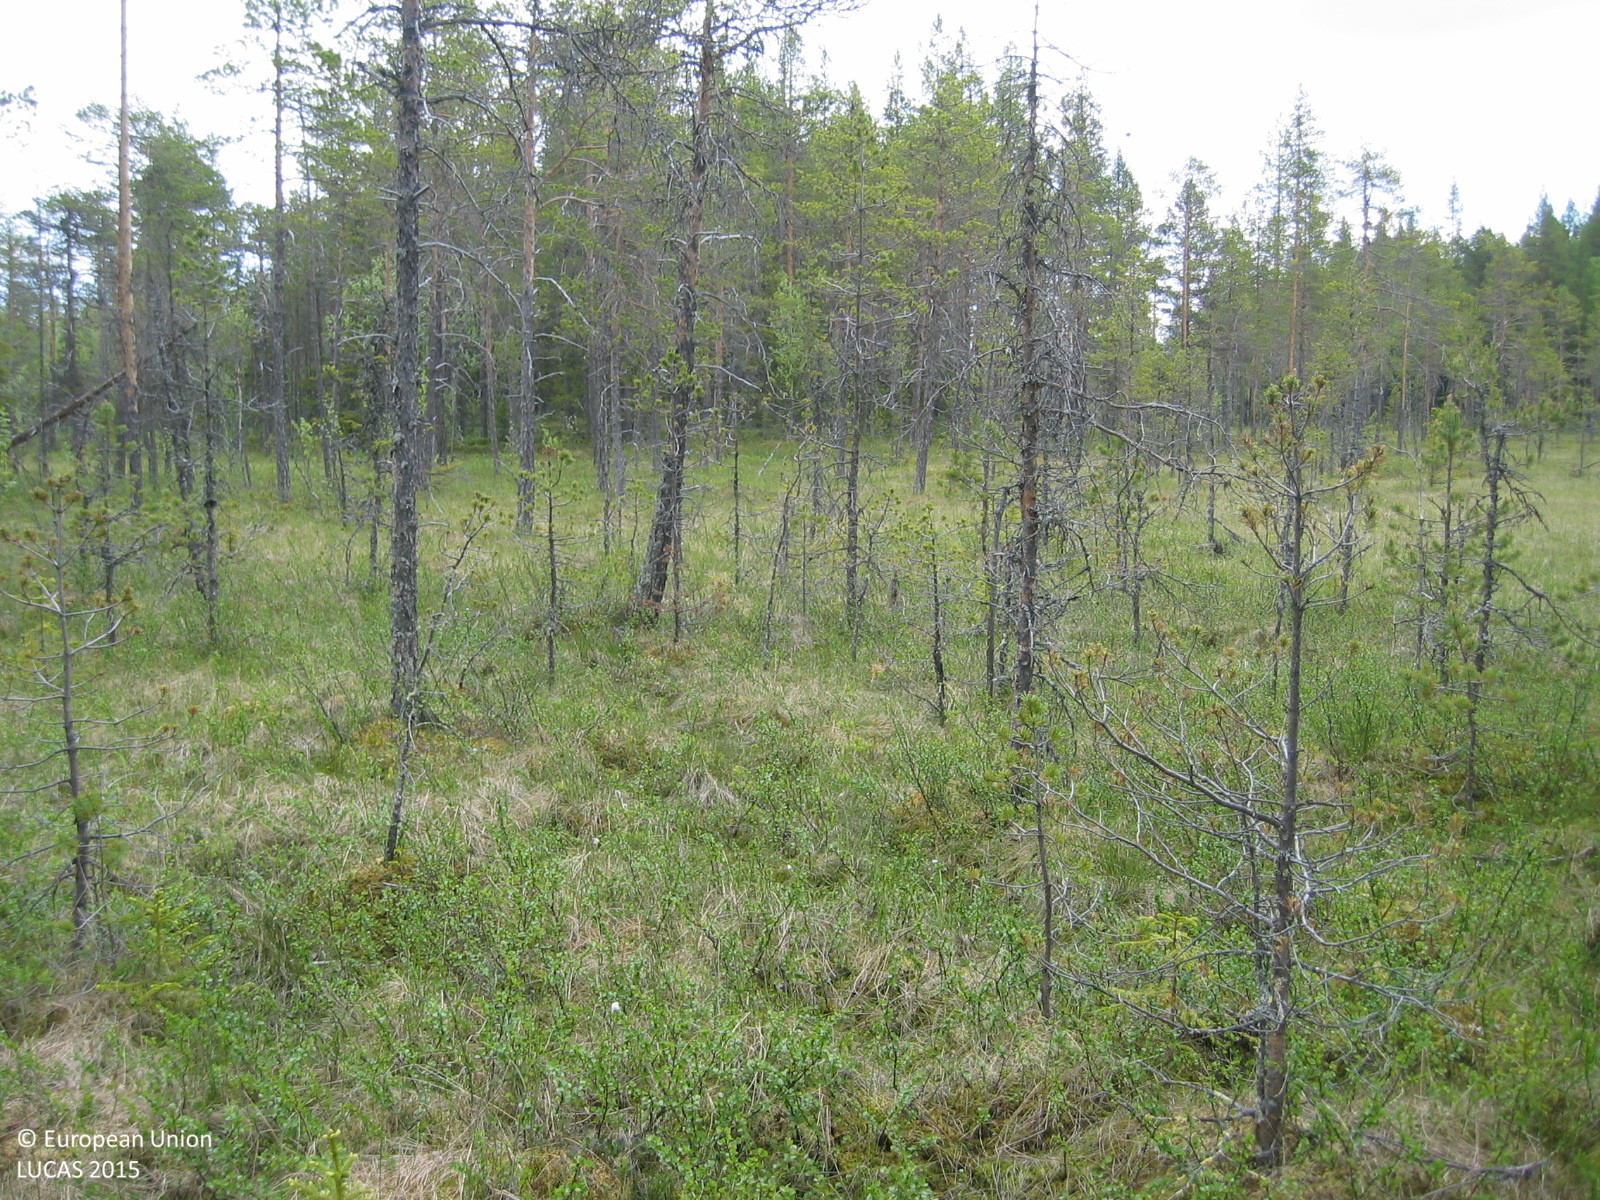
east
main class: Woodland
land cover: Pine dominated coniferous woodland
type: boreal forest
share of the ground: 50 - 75 %
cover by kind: coniferous forest trees 60 %, shrubs 40 %
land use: Semi-natural and natural areas not in use
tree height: > 5 m
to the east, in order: Pine dominated coniferous woodland; Spruce dominated coniferous woodland; Tracks; Spruce dominated mixed woodland
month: June
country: SE
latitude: 63.5327
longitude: 14.7031
